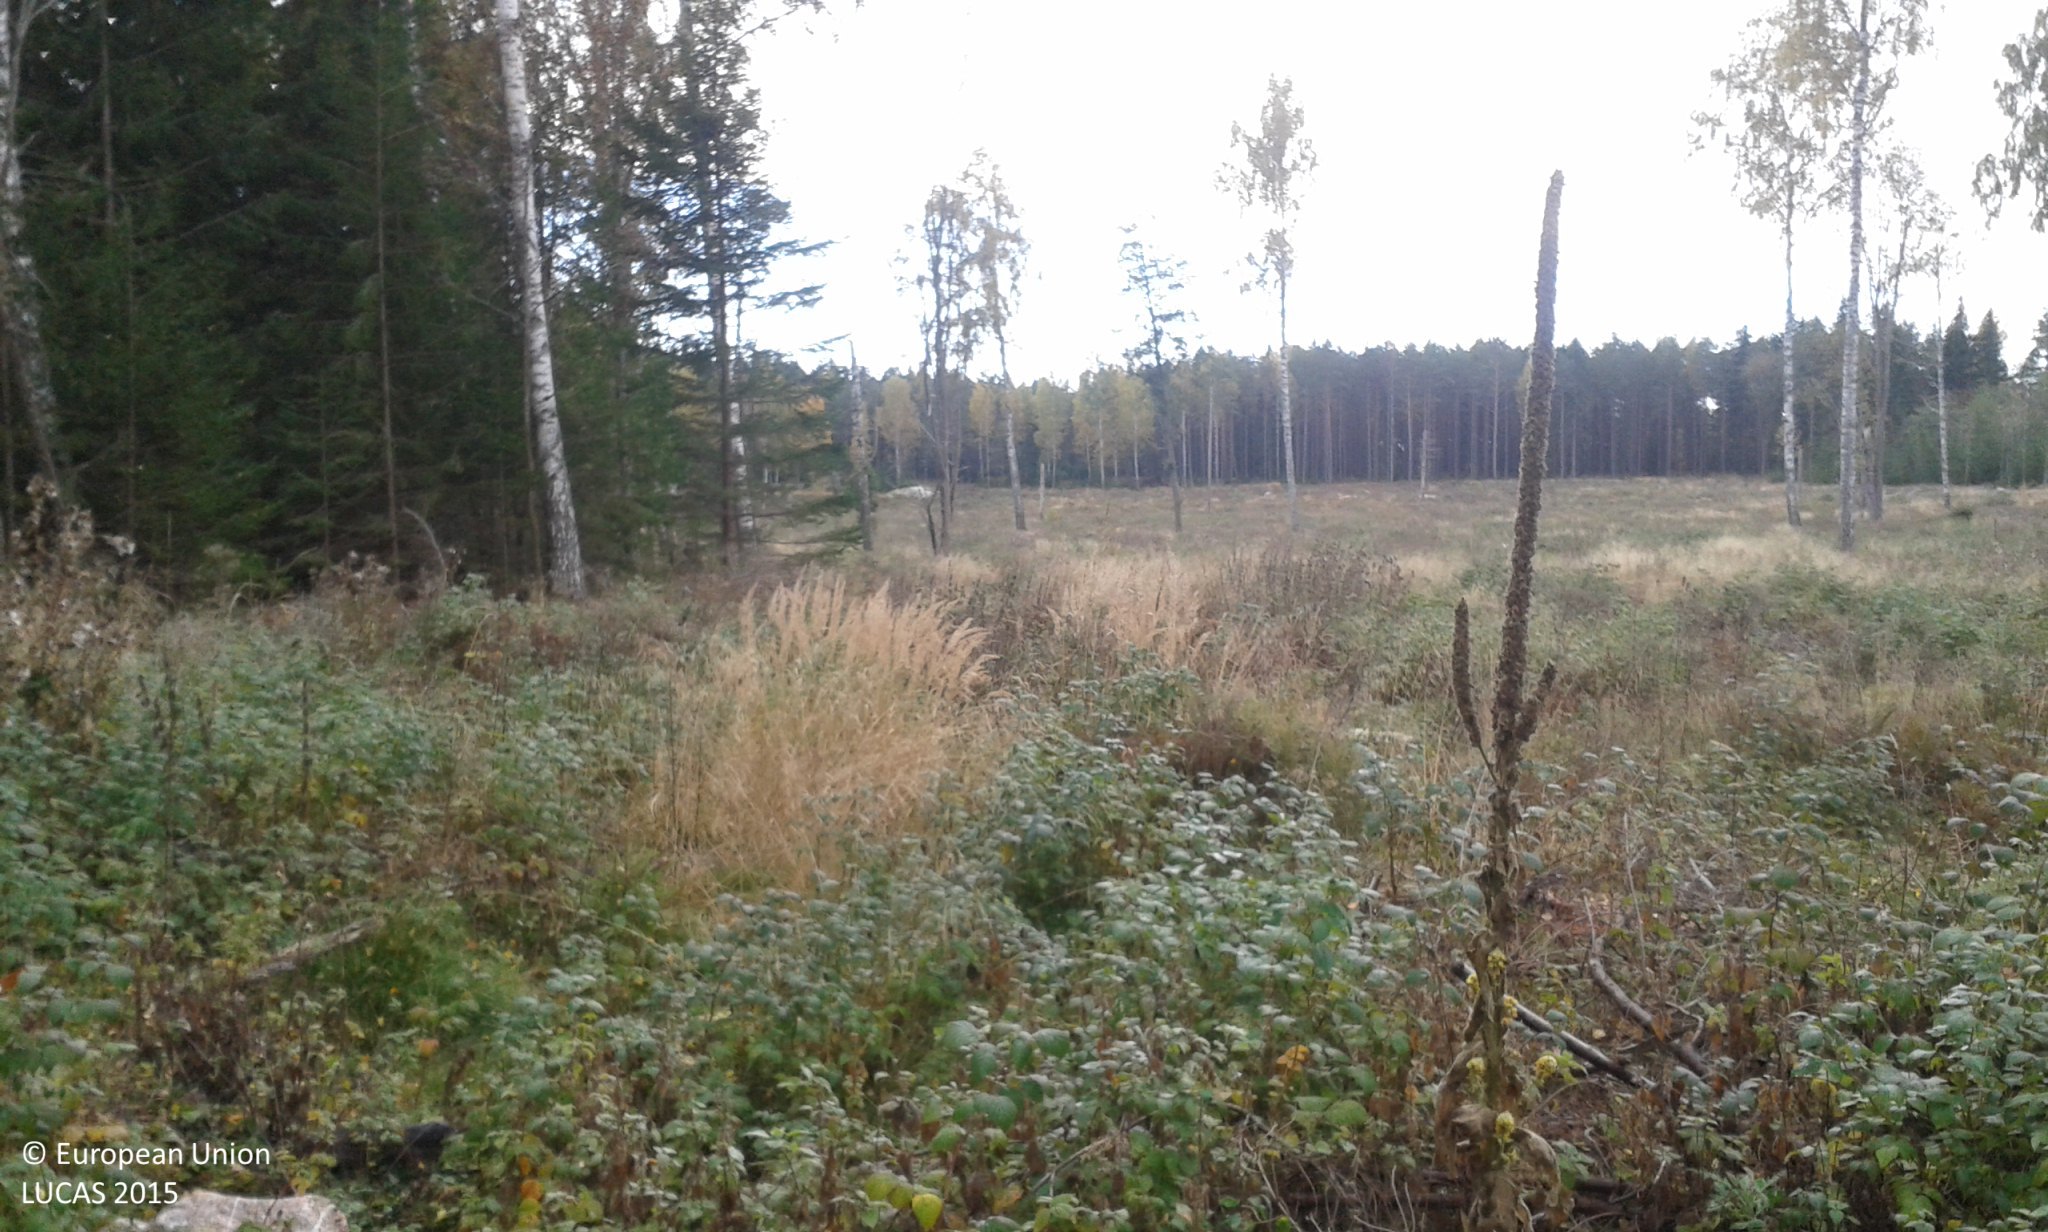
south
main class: Grassland
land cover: Spontaneously vegetated surfaces
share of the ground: > 75 %
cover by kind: herbaceous plants 100 %
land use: Forestry
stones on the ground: 10 - 25 %
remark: Clear cut
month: October
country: SE
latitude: 58.7614
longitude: 17.3106
